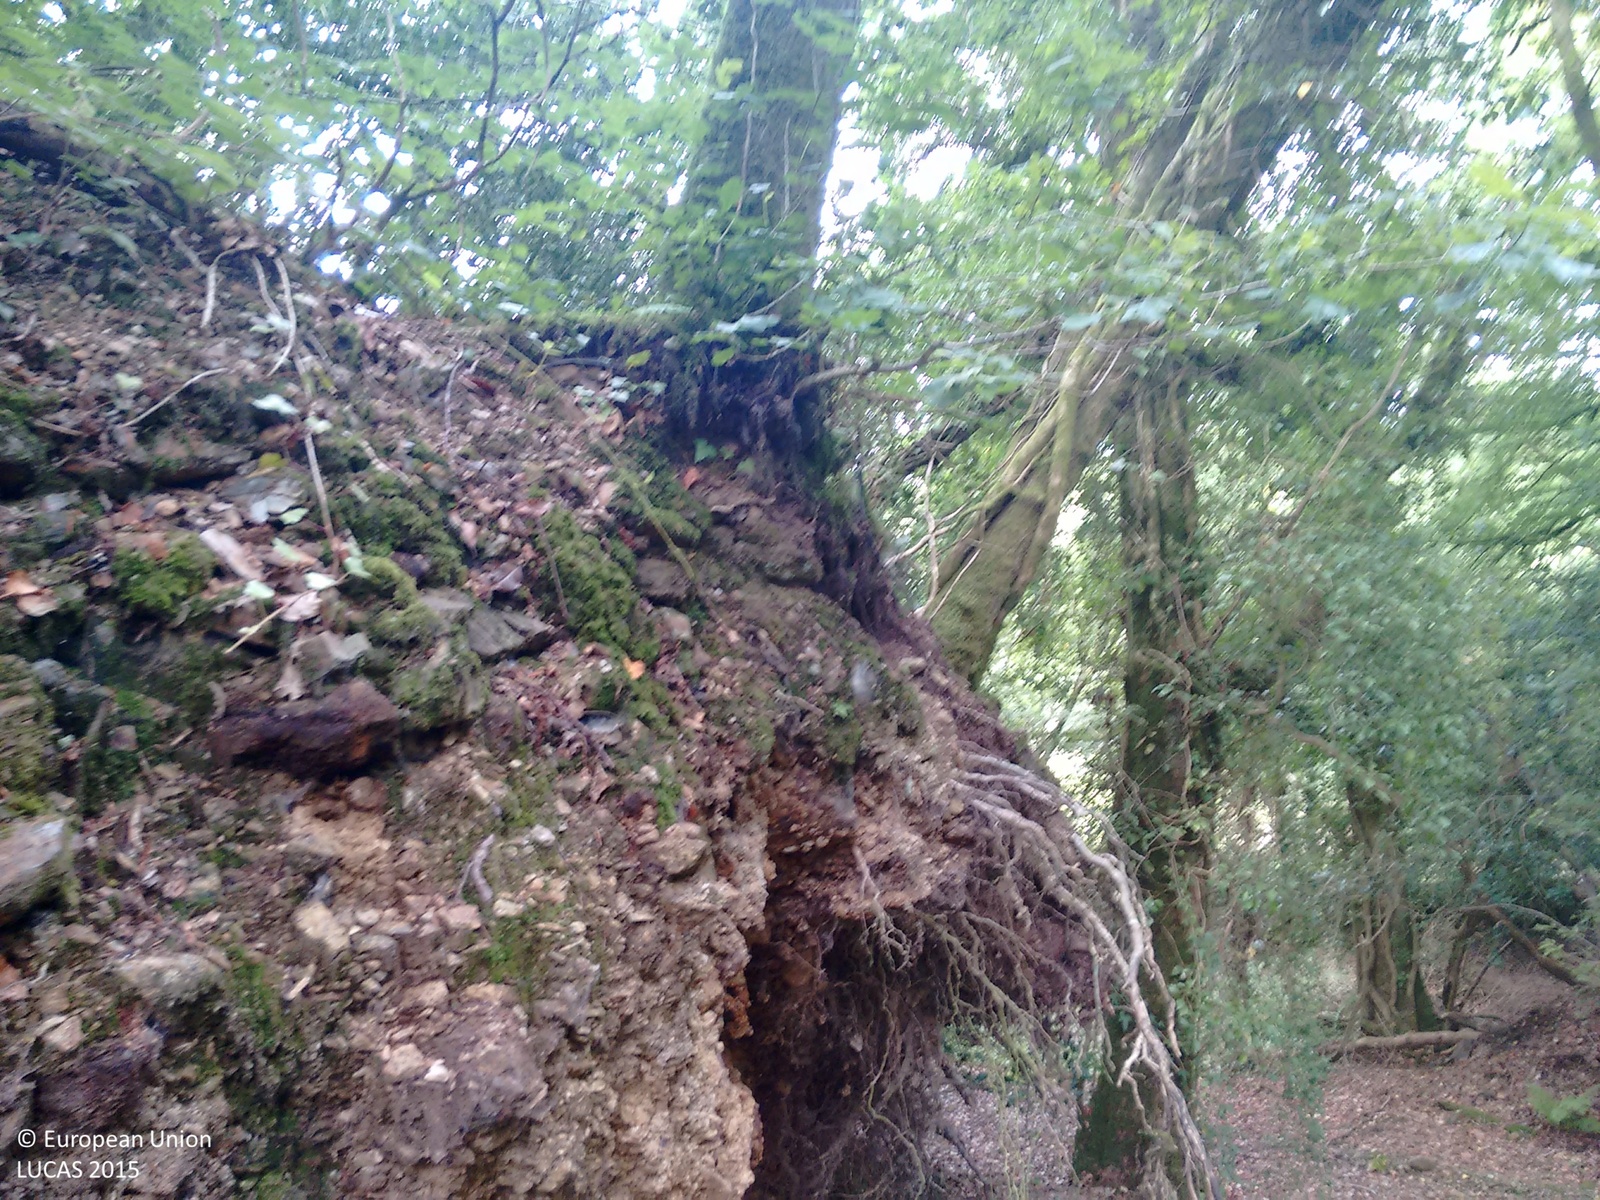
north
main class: Woodland
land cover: Broadleaved woodland
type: acidophilous oak and oak-birch forest
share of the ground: > 75 %
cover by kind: broadleaved forest trees 100 %
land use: Semi-natural and natural areas not in use
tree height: > 5 m
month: August
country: GB
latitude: 50.4870
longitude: -4.4082
